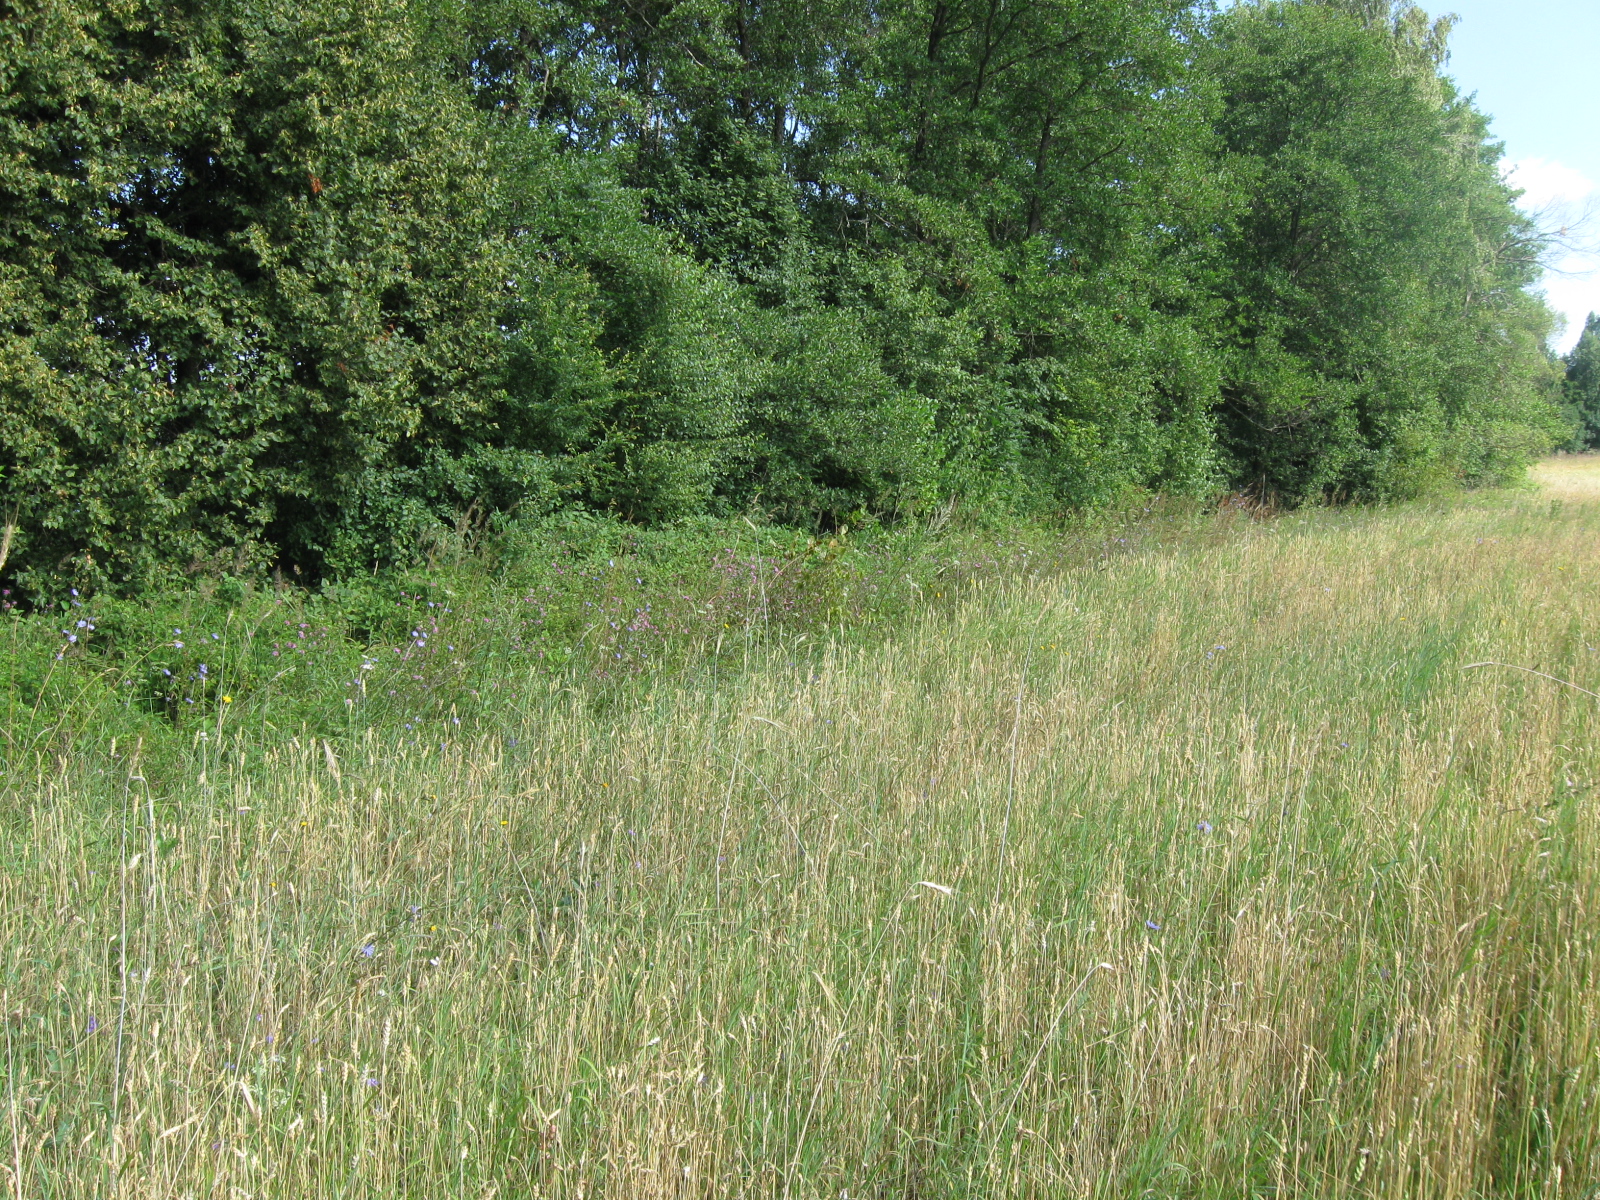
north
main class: Cropland
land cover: Common wheat
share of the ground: > 75 %
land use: Agriculture (excluding fallow land and kitchen gardens)
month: July
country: LT
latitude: 54.0502
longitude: 23.7894
